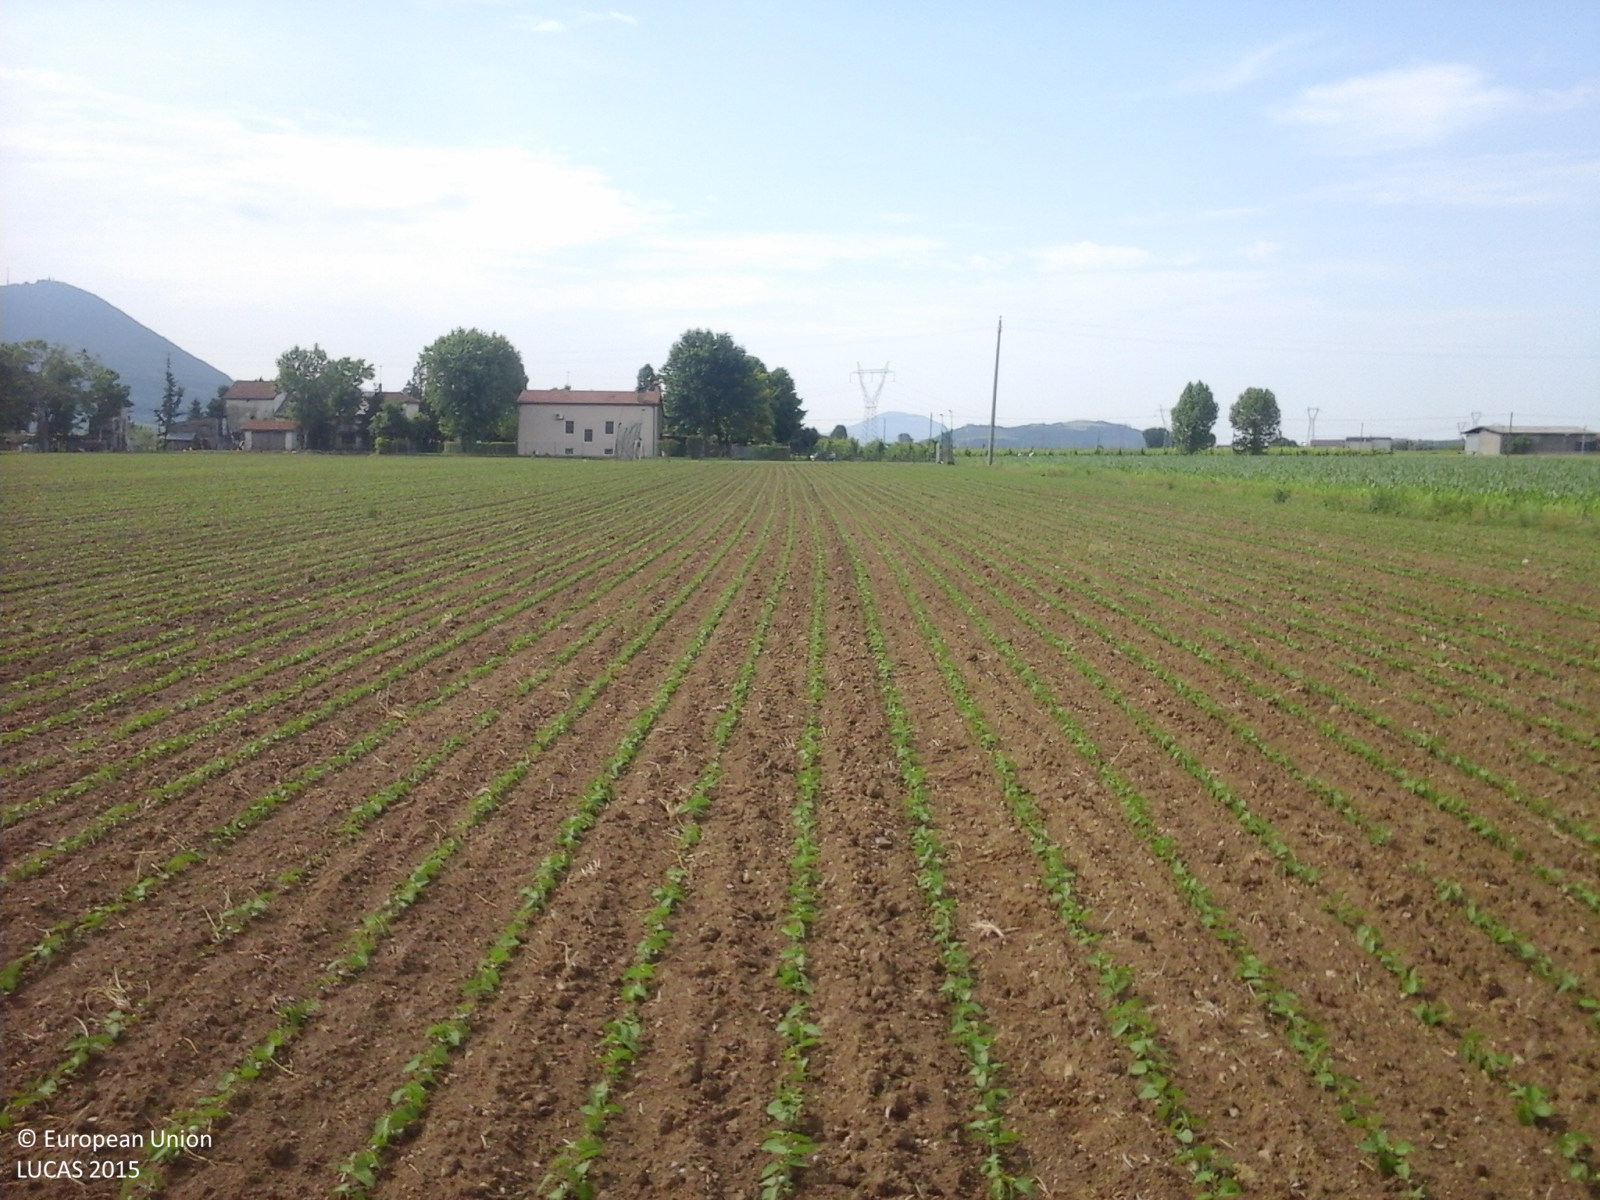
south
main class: Cropland
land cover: Soya
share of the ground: < 10 %
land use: Agriculture (excluding fallow land and kitchen gardens)
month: May
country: IT
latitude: 45.4019
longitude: 11.6198
